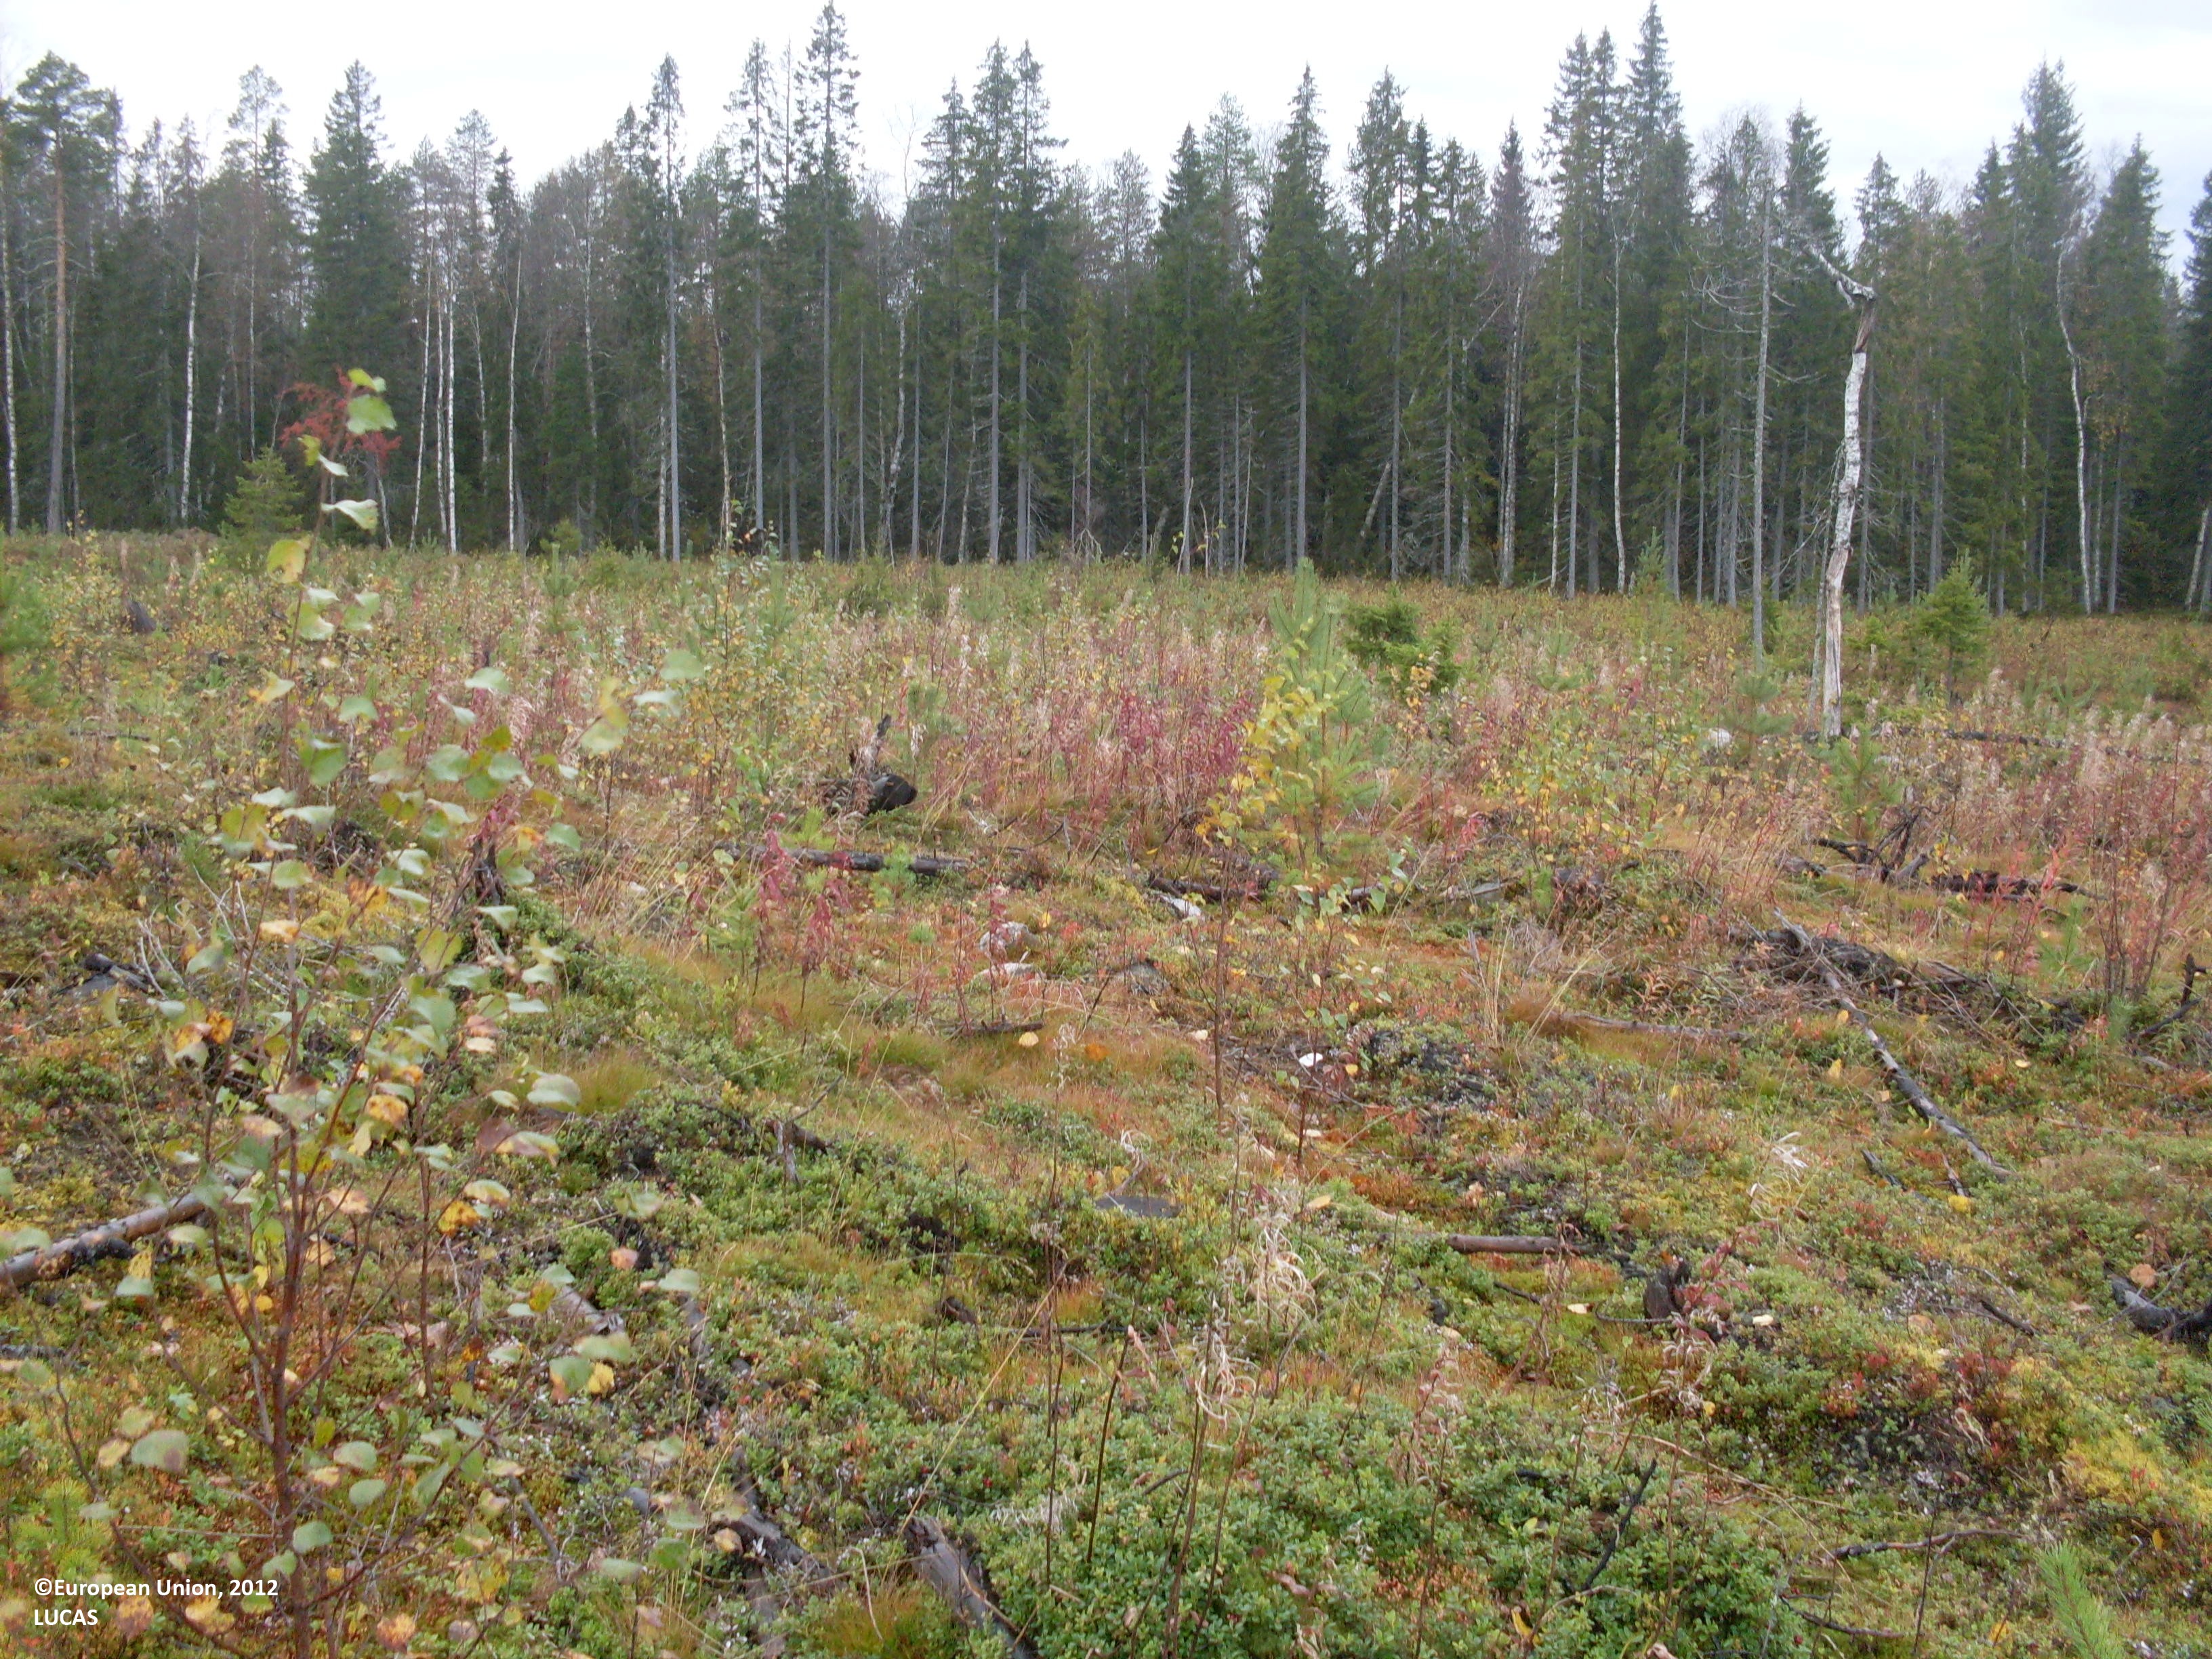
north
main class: Shrubland
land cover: Shrubland with sparse tree cover
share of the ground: 25 - 50 %
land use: Forestry
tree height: < 5 m
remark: Clear cut
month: September
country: FI
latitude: 64.4866
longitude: 28.6813
